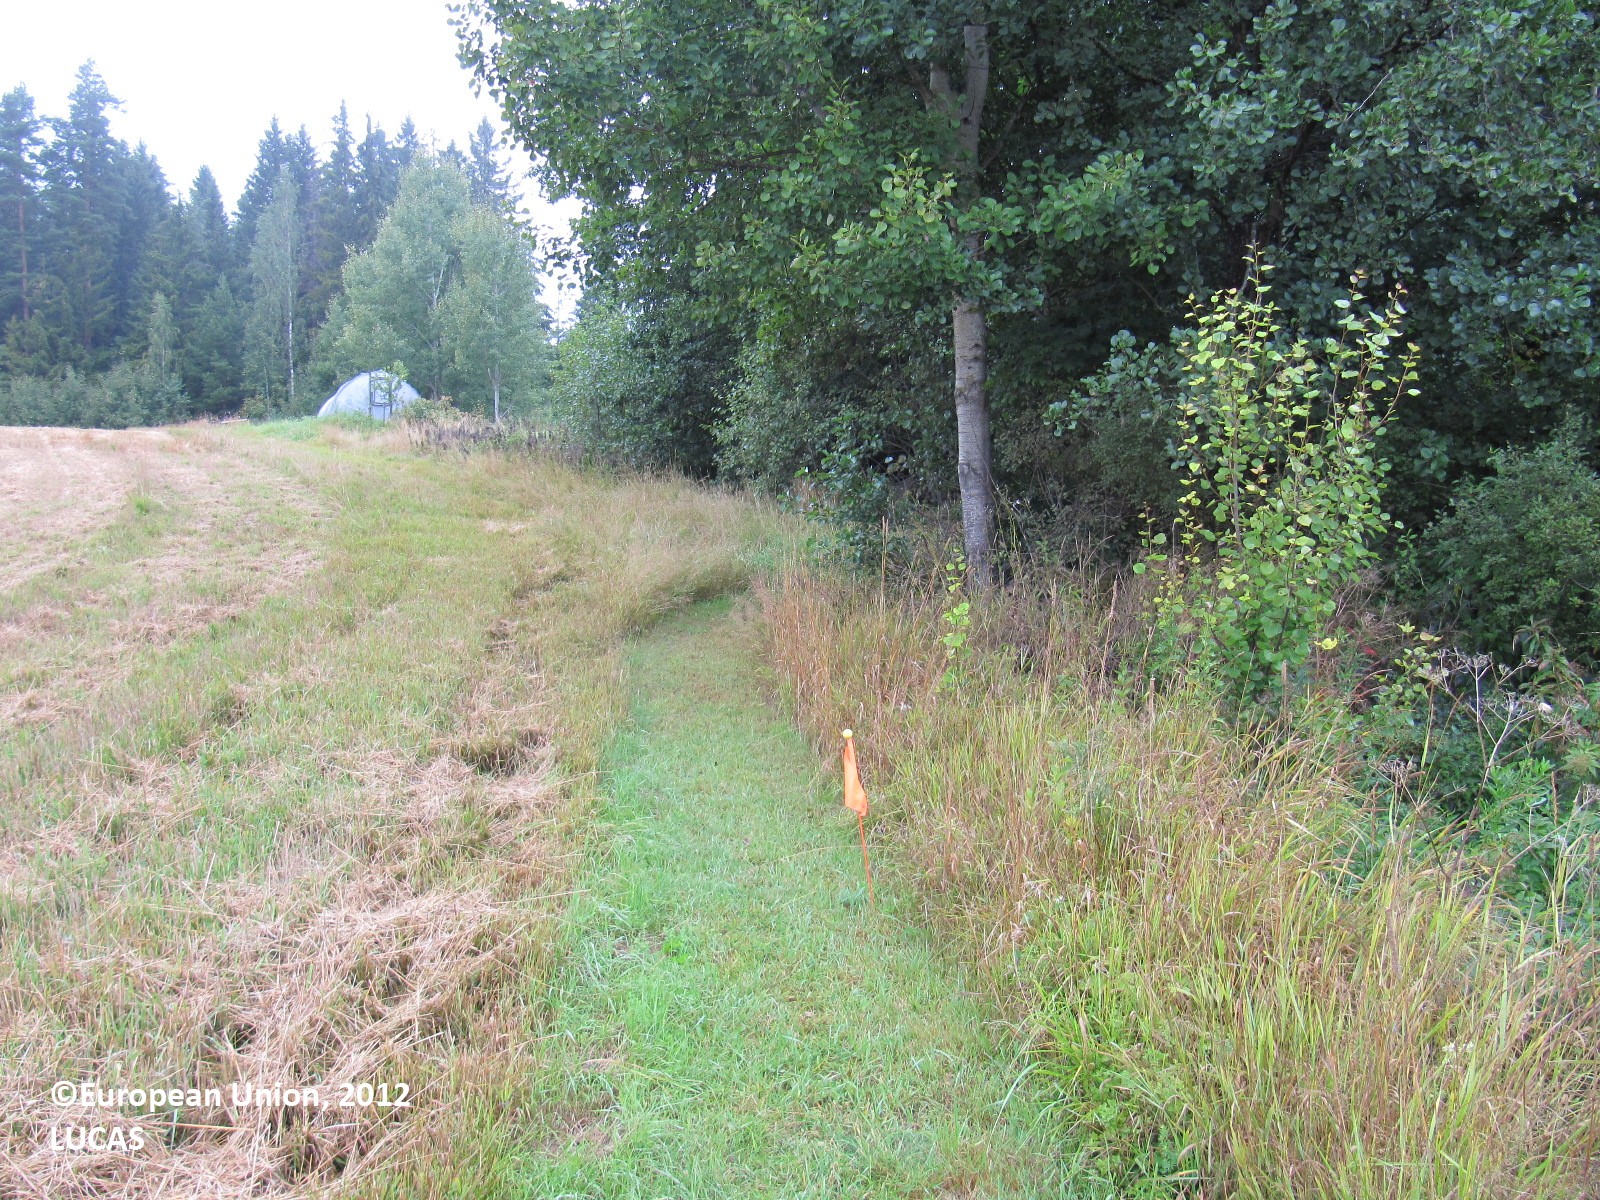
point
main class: Grassland
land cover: Spontaneously vegetated surfaces
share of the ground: > 75 %
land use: Agriculture (excluding fallow land and kitchen gardens)
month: August
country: FI
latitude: 60.1986
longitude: 24.3005
